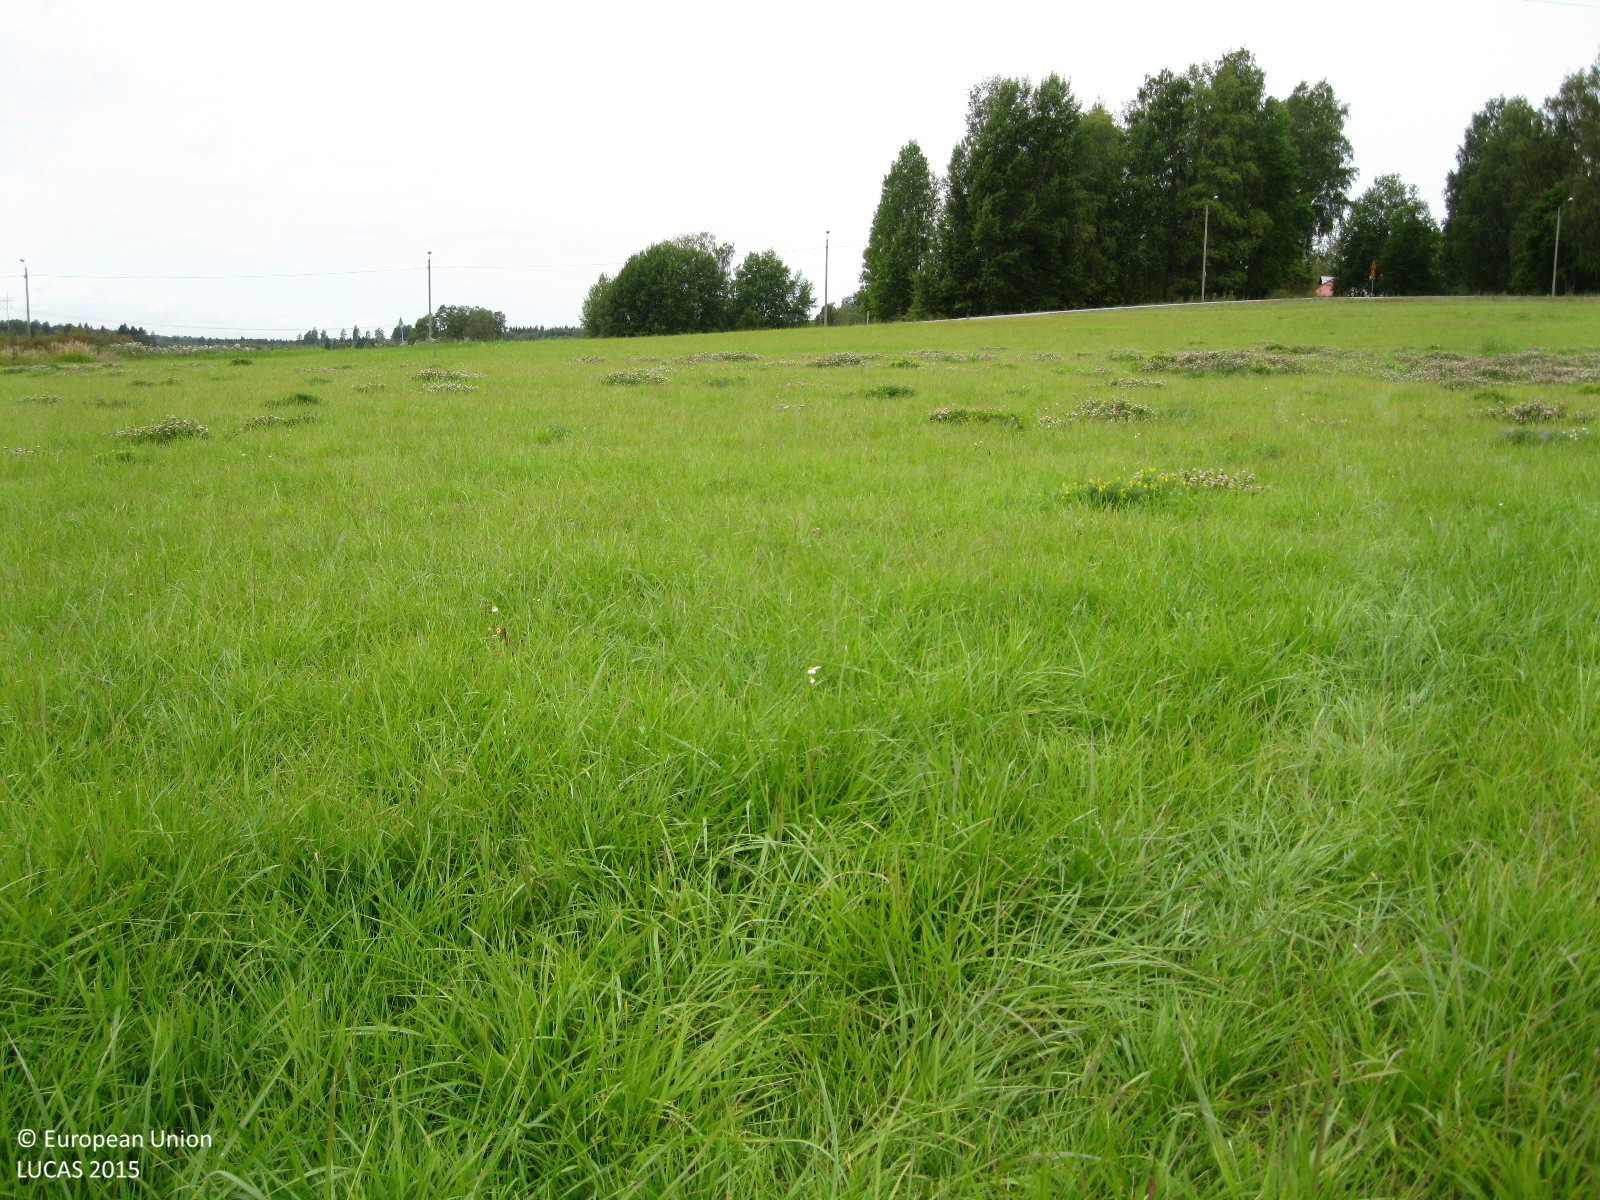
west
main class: Cropland
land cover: Temporary grasslands
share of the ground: > 75 %
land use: Agriculture (excluding fallow land and kitchen gardens)
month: September
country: FI
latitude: 60.4040
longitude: 24.7984
